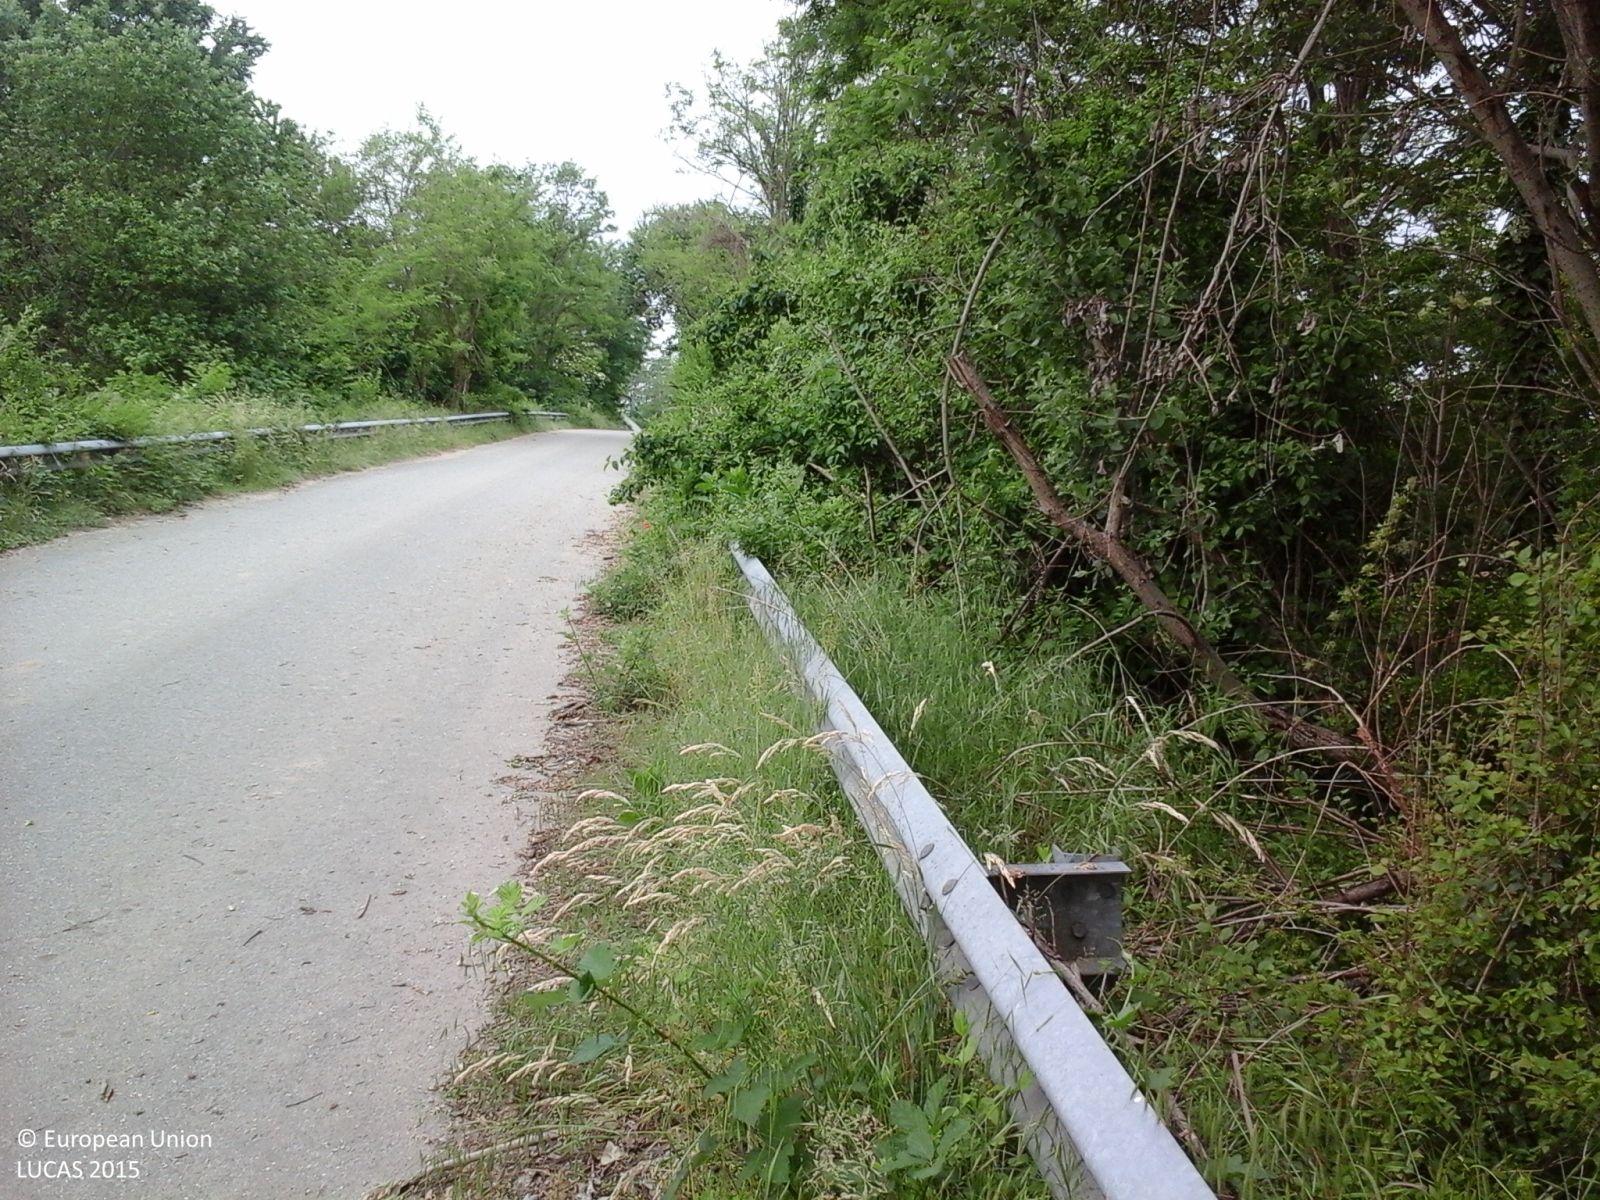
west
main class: Woodland
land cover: Broadleaved woodland
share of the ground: > 75 %
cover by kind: broadleaved forest trees 100 %
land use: Forestry
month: May
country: IT
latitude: 45.5468
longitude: 8.4271
